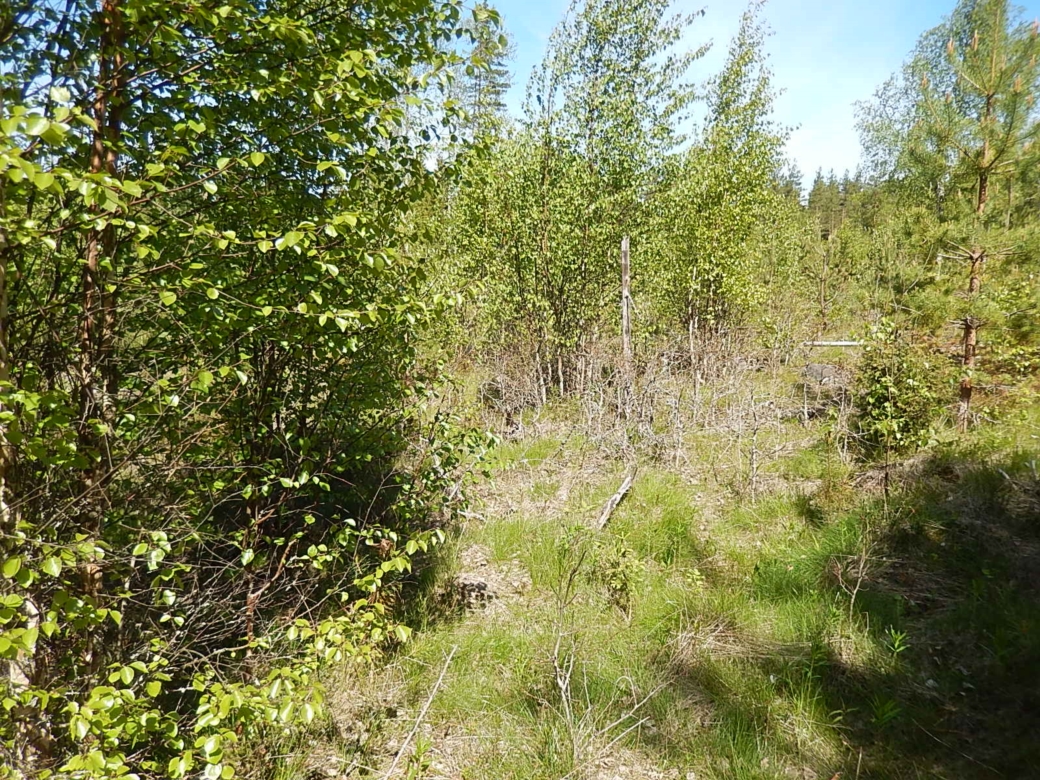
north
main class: Woodland
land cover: Other mixed woodland
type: boreal forest
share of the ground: 50 - 75 %
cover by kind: herbaceous plants 35 %, broadleaved forest trees 30 %, coniferous forest trees 20 %, lichens and mosses 10 %, shrubs 5 %
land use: Forestry
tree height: > 5 m
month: June
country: FI
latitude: 62.0987
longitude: 21.4821
